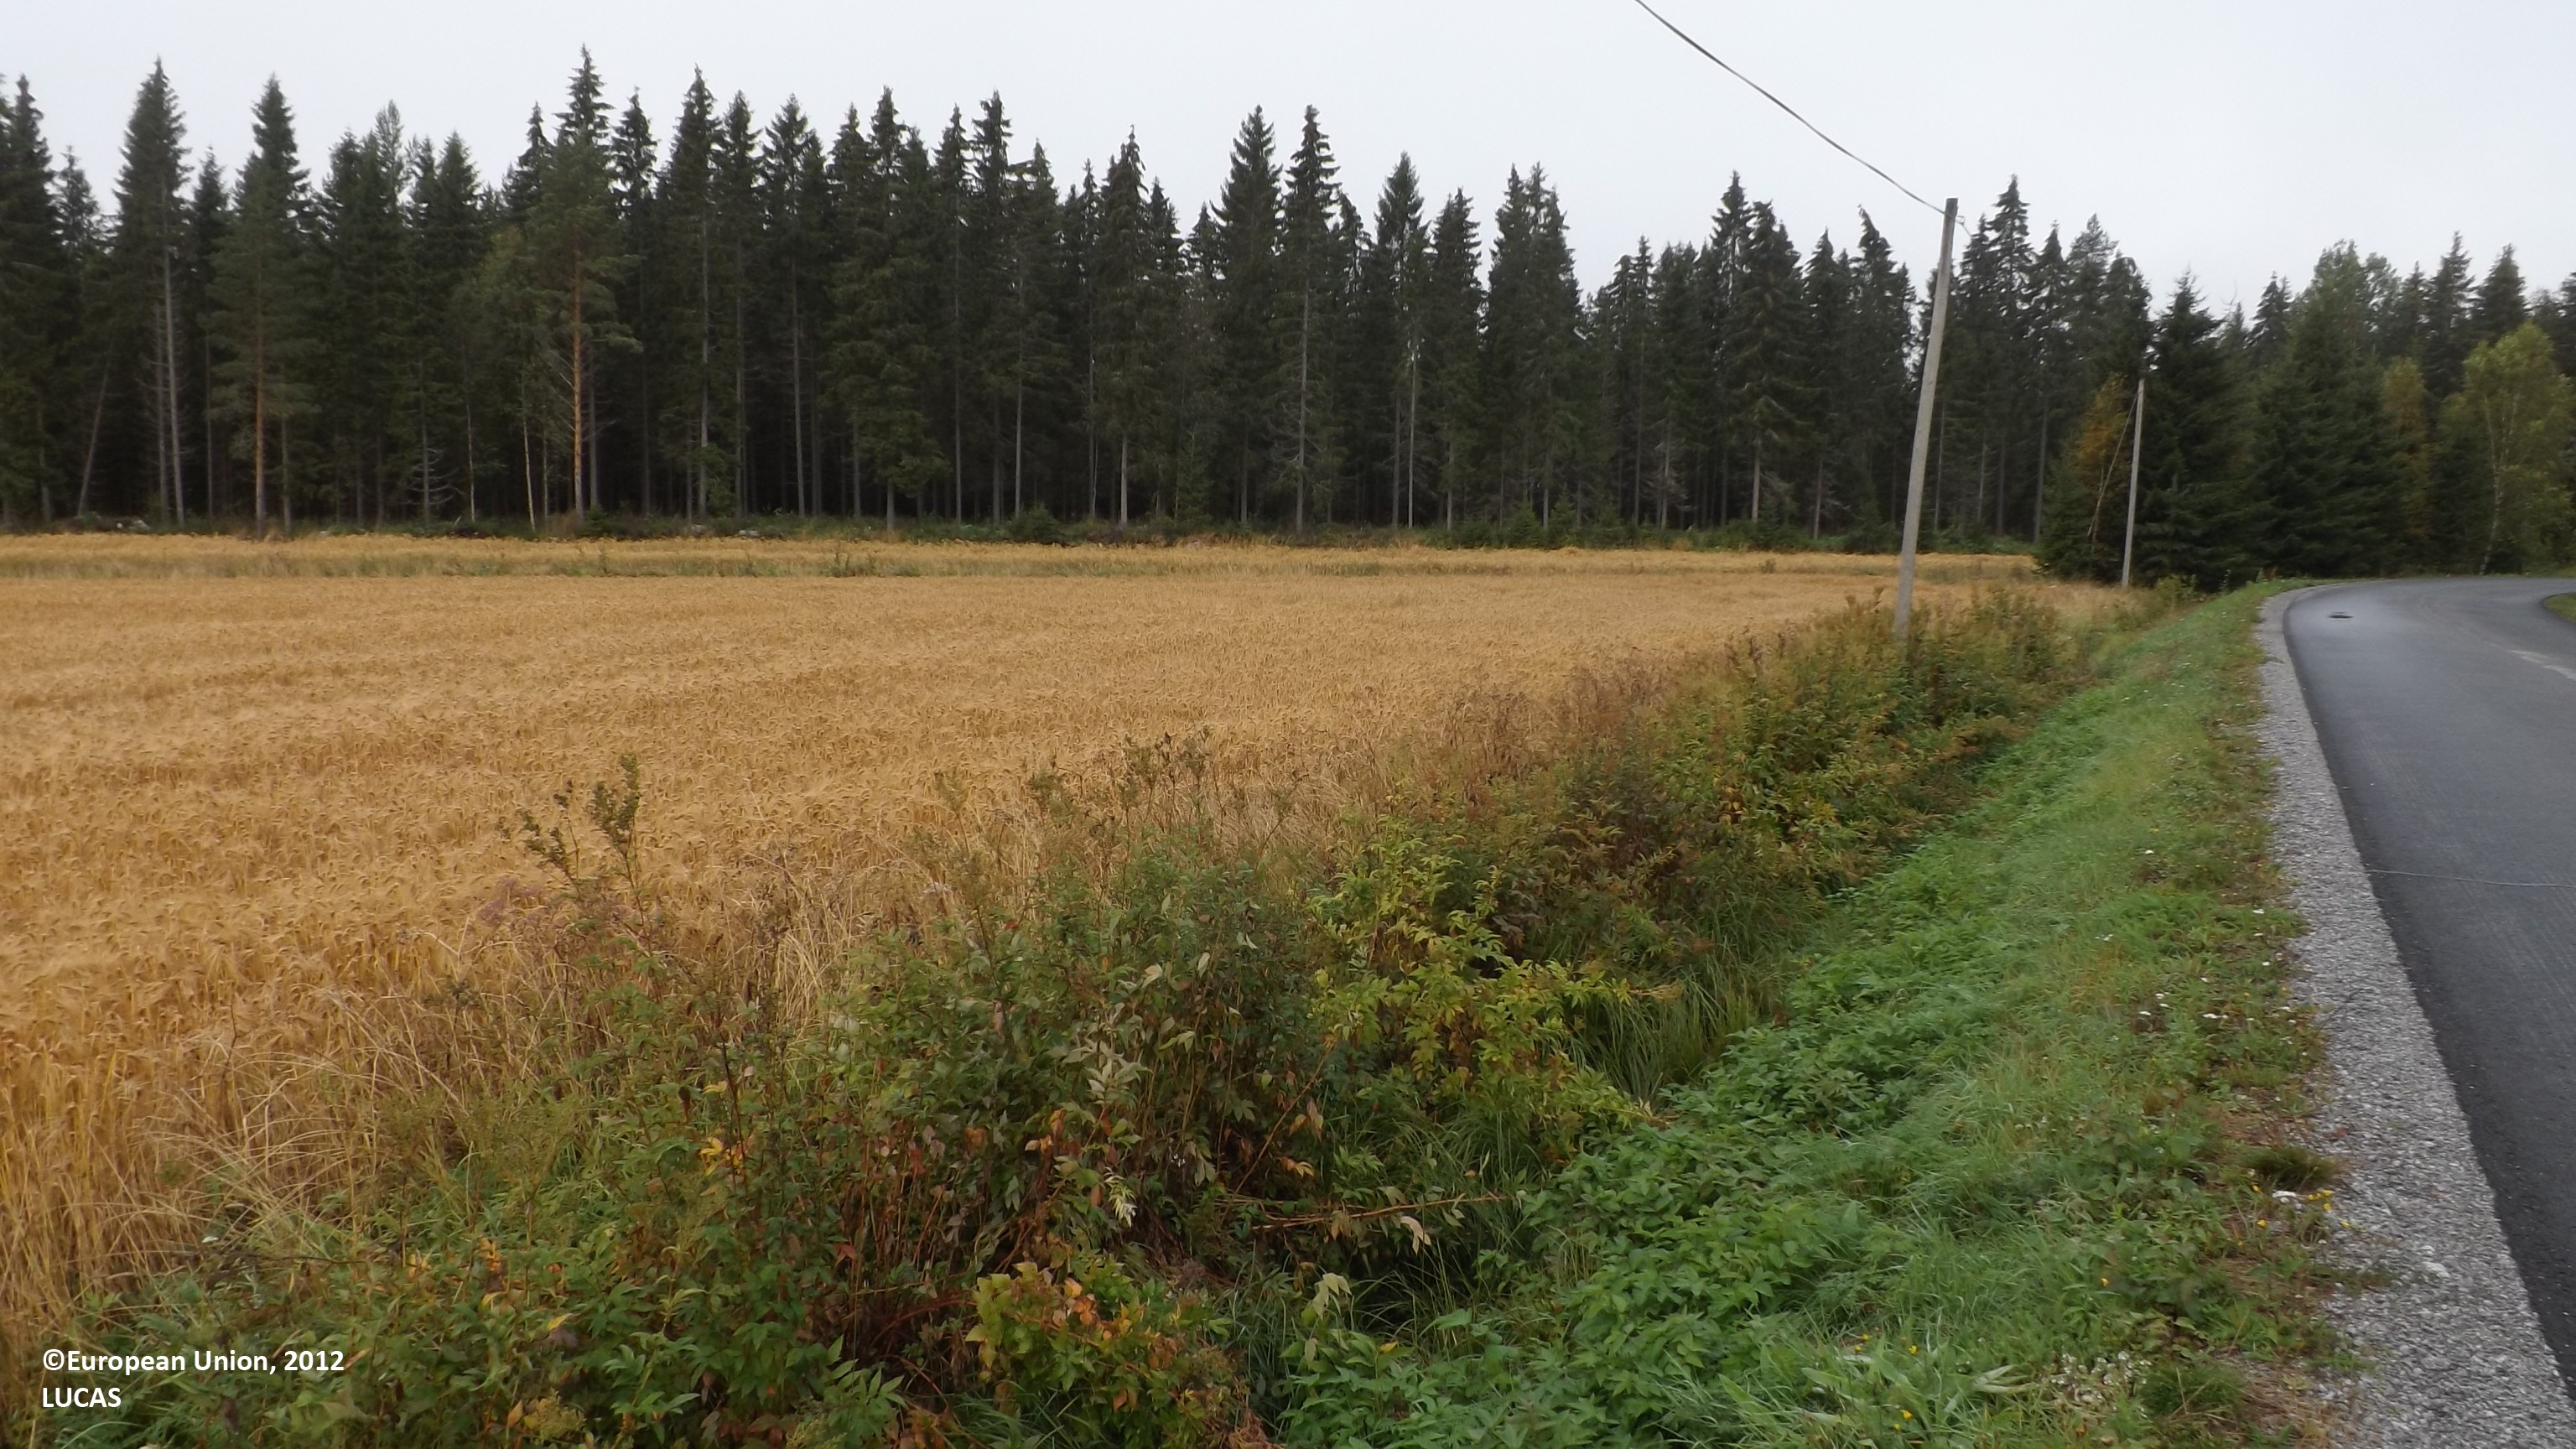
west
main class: Grassland
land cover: Spontaneously vegetated surfaces
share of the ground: > 75 %
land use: Road transport
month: August
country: FI
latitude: 63.8364
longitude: 23.2883
